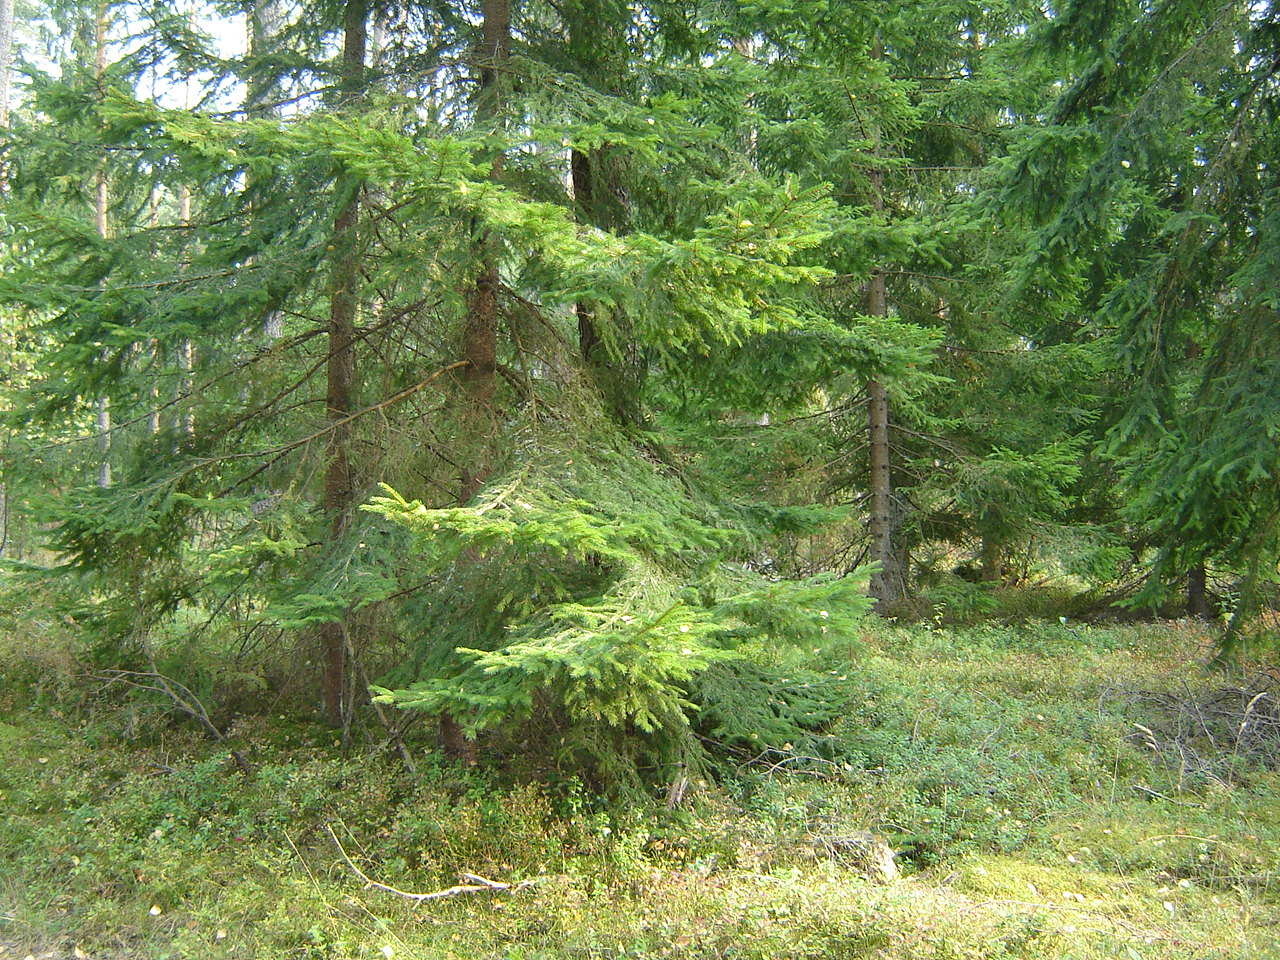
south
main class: Woodland
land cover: Pine dominated mixed woodland
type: hemiboreal forest and nemoral coniferous forest and mixed broadleaved-coniferous forest
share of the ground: > 75 %
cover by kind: coniferous forest trees 55 %, broadleaved forest trees 30 %, shrubs 5 %, herbaceous plants 5 %, lichens and mosses 5 %
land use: Forestry
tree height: > 5 m
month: September
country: LT
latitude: 54.4883
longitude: 24.8852
